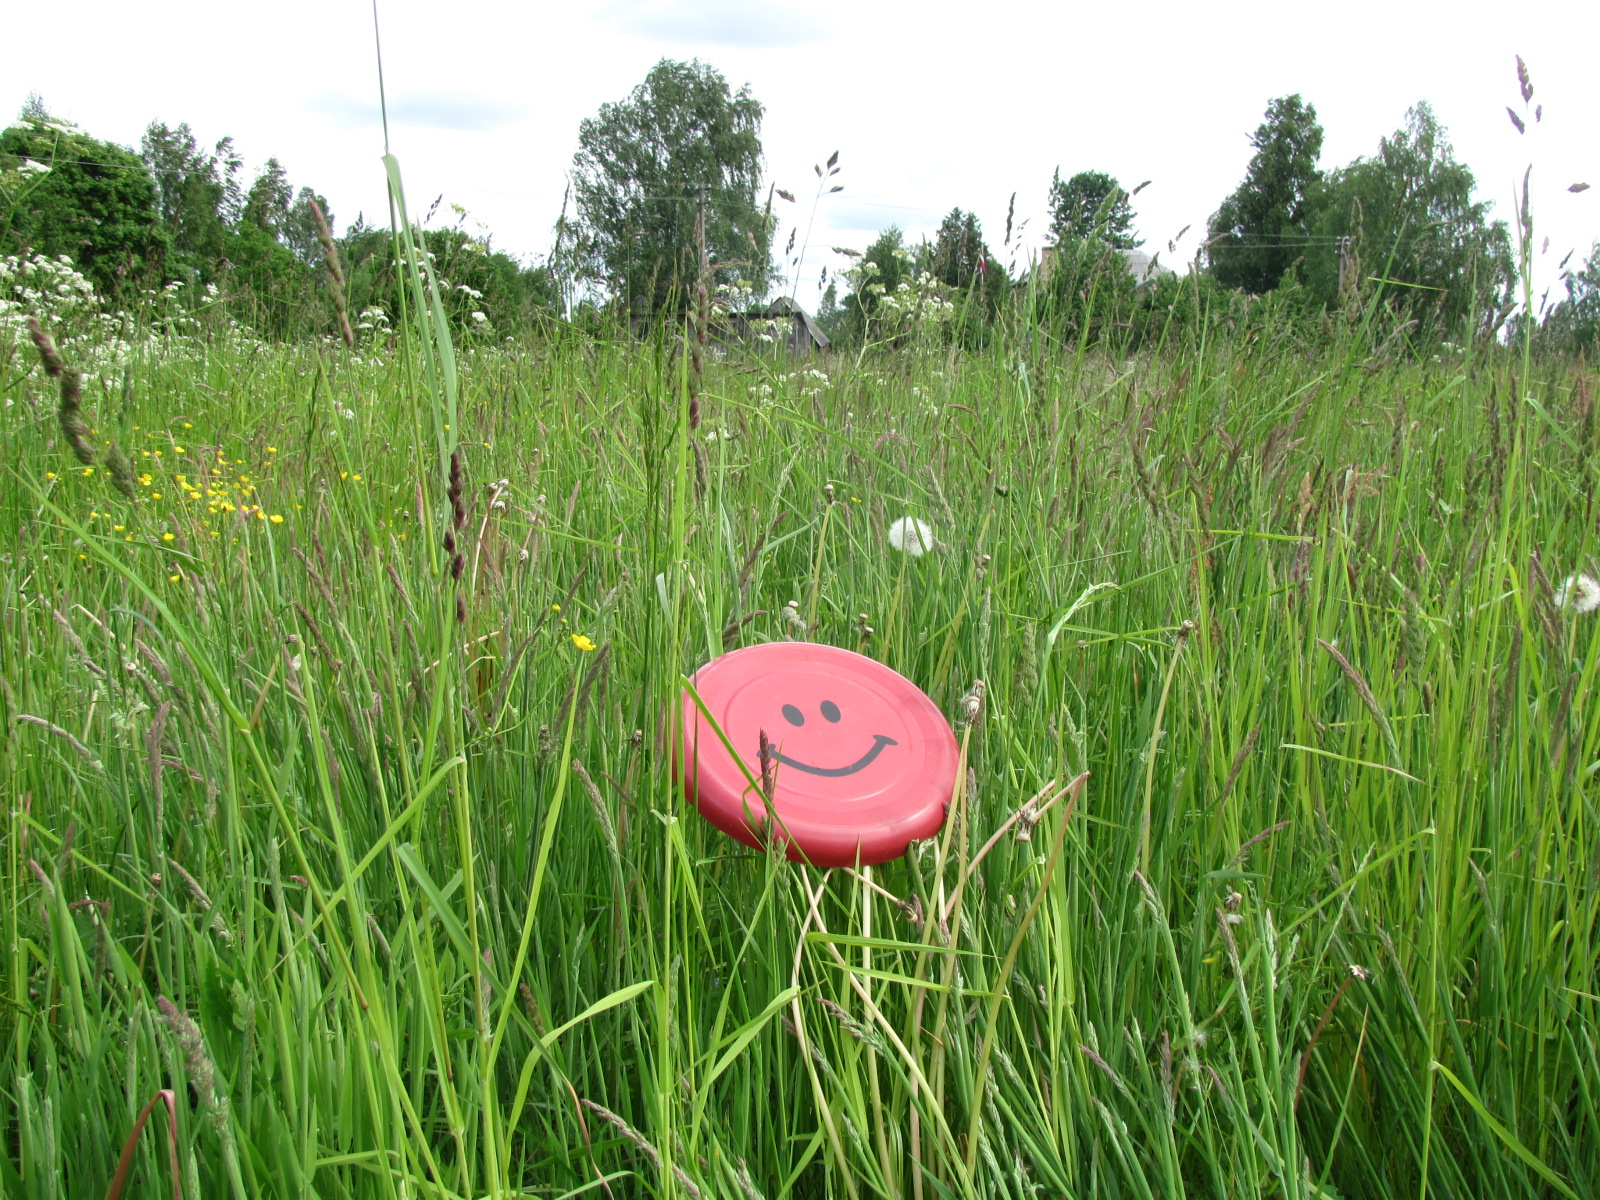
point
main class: Grassland
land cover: Grassland without tree/shrub cover
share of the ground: > 75 %
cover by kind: herbaceous plants 100 %
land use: Agriculture (excluding fallow land and kitchen gardens)
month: June
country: LV
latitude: 56.6757
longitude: 23.8396
